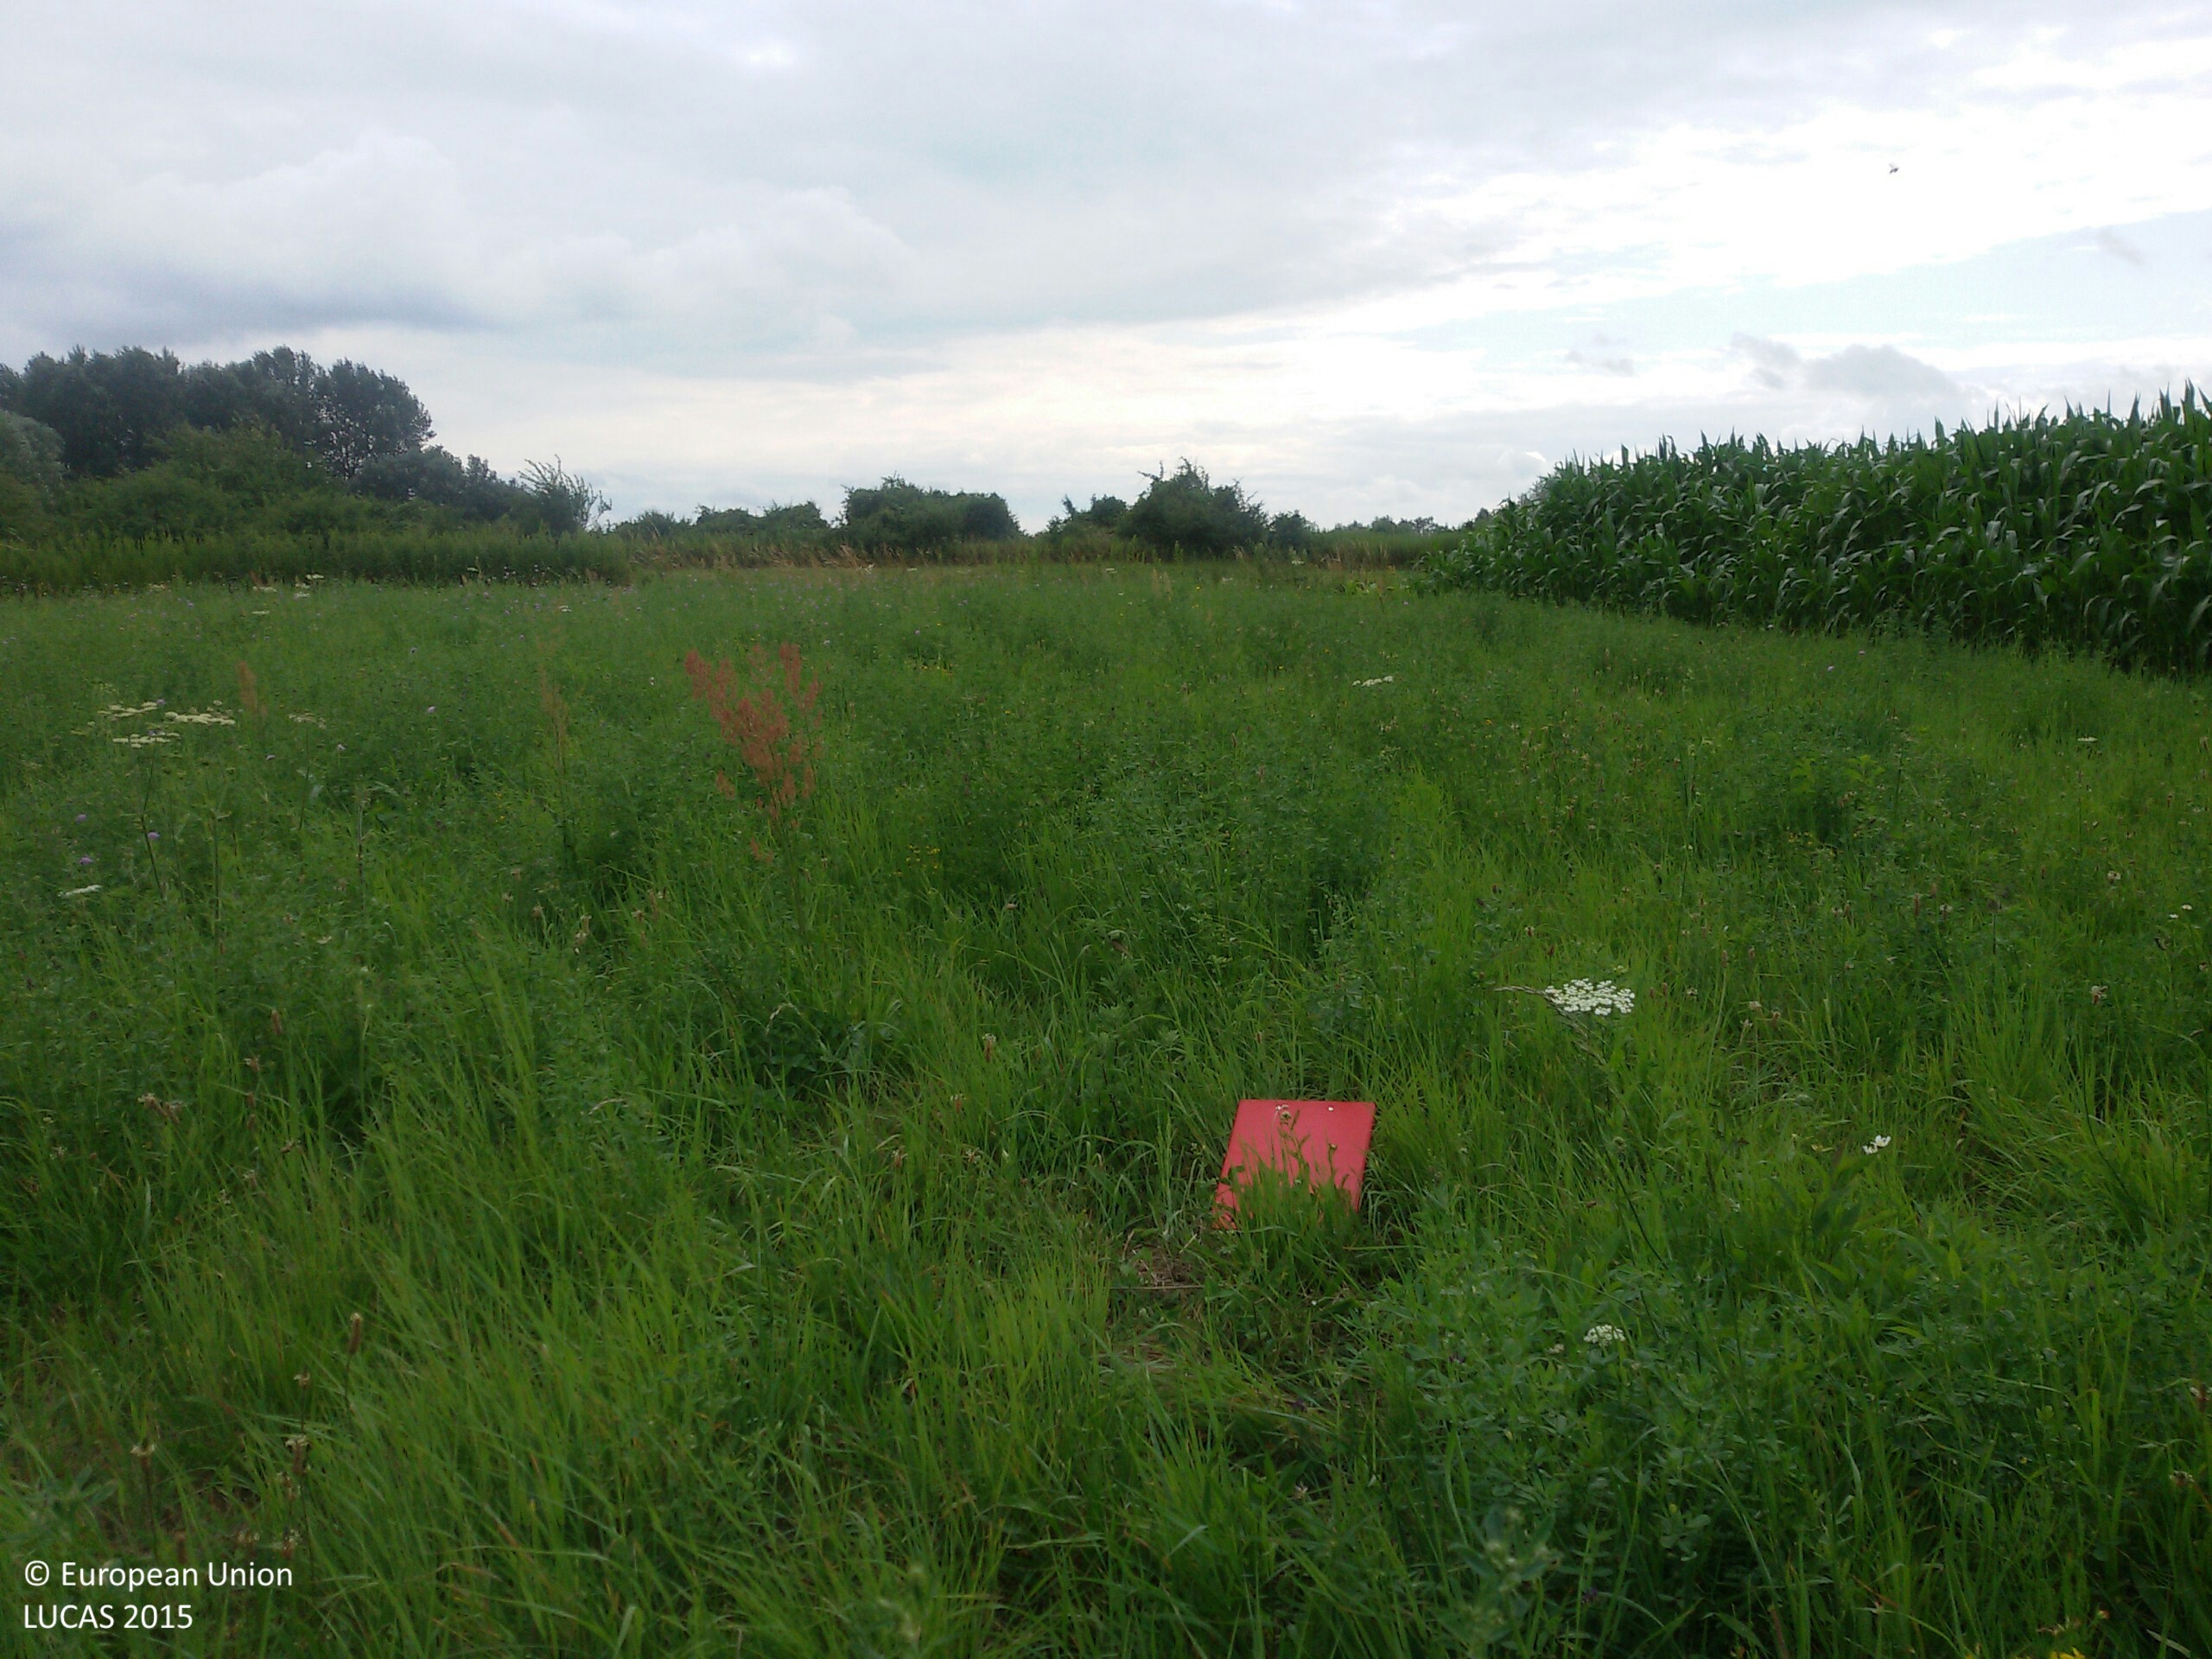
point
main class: Grassland
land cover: Grassland without tree/shrub cover
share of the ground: > 75 %
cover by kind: herbaceous plants 100 %
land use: Agriculture (excluding fallow land and kitchen gardens)
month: July
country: PL
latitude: 50.1998
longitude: 20.7580
